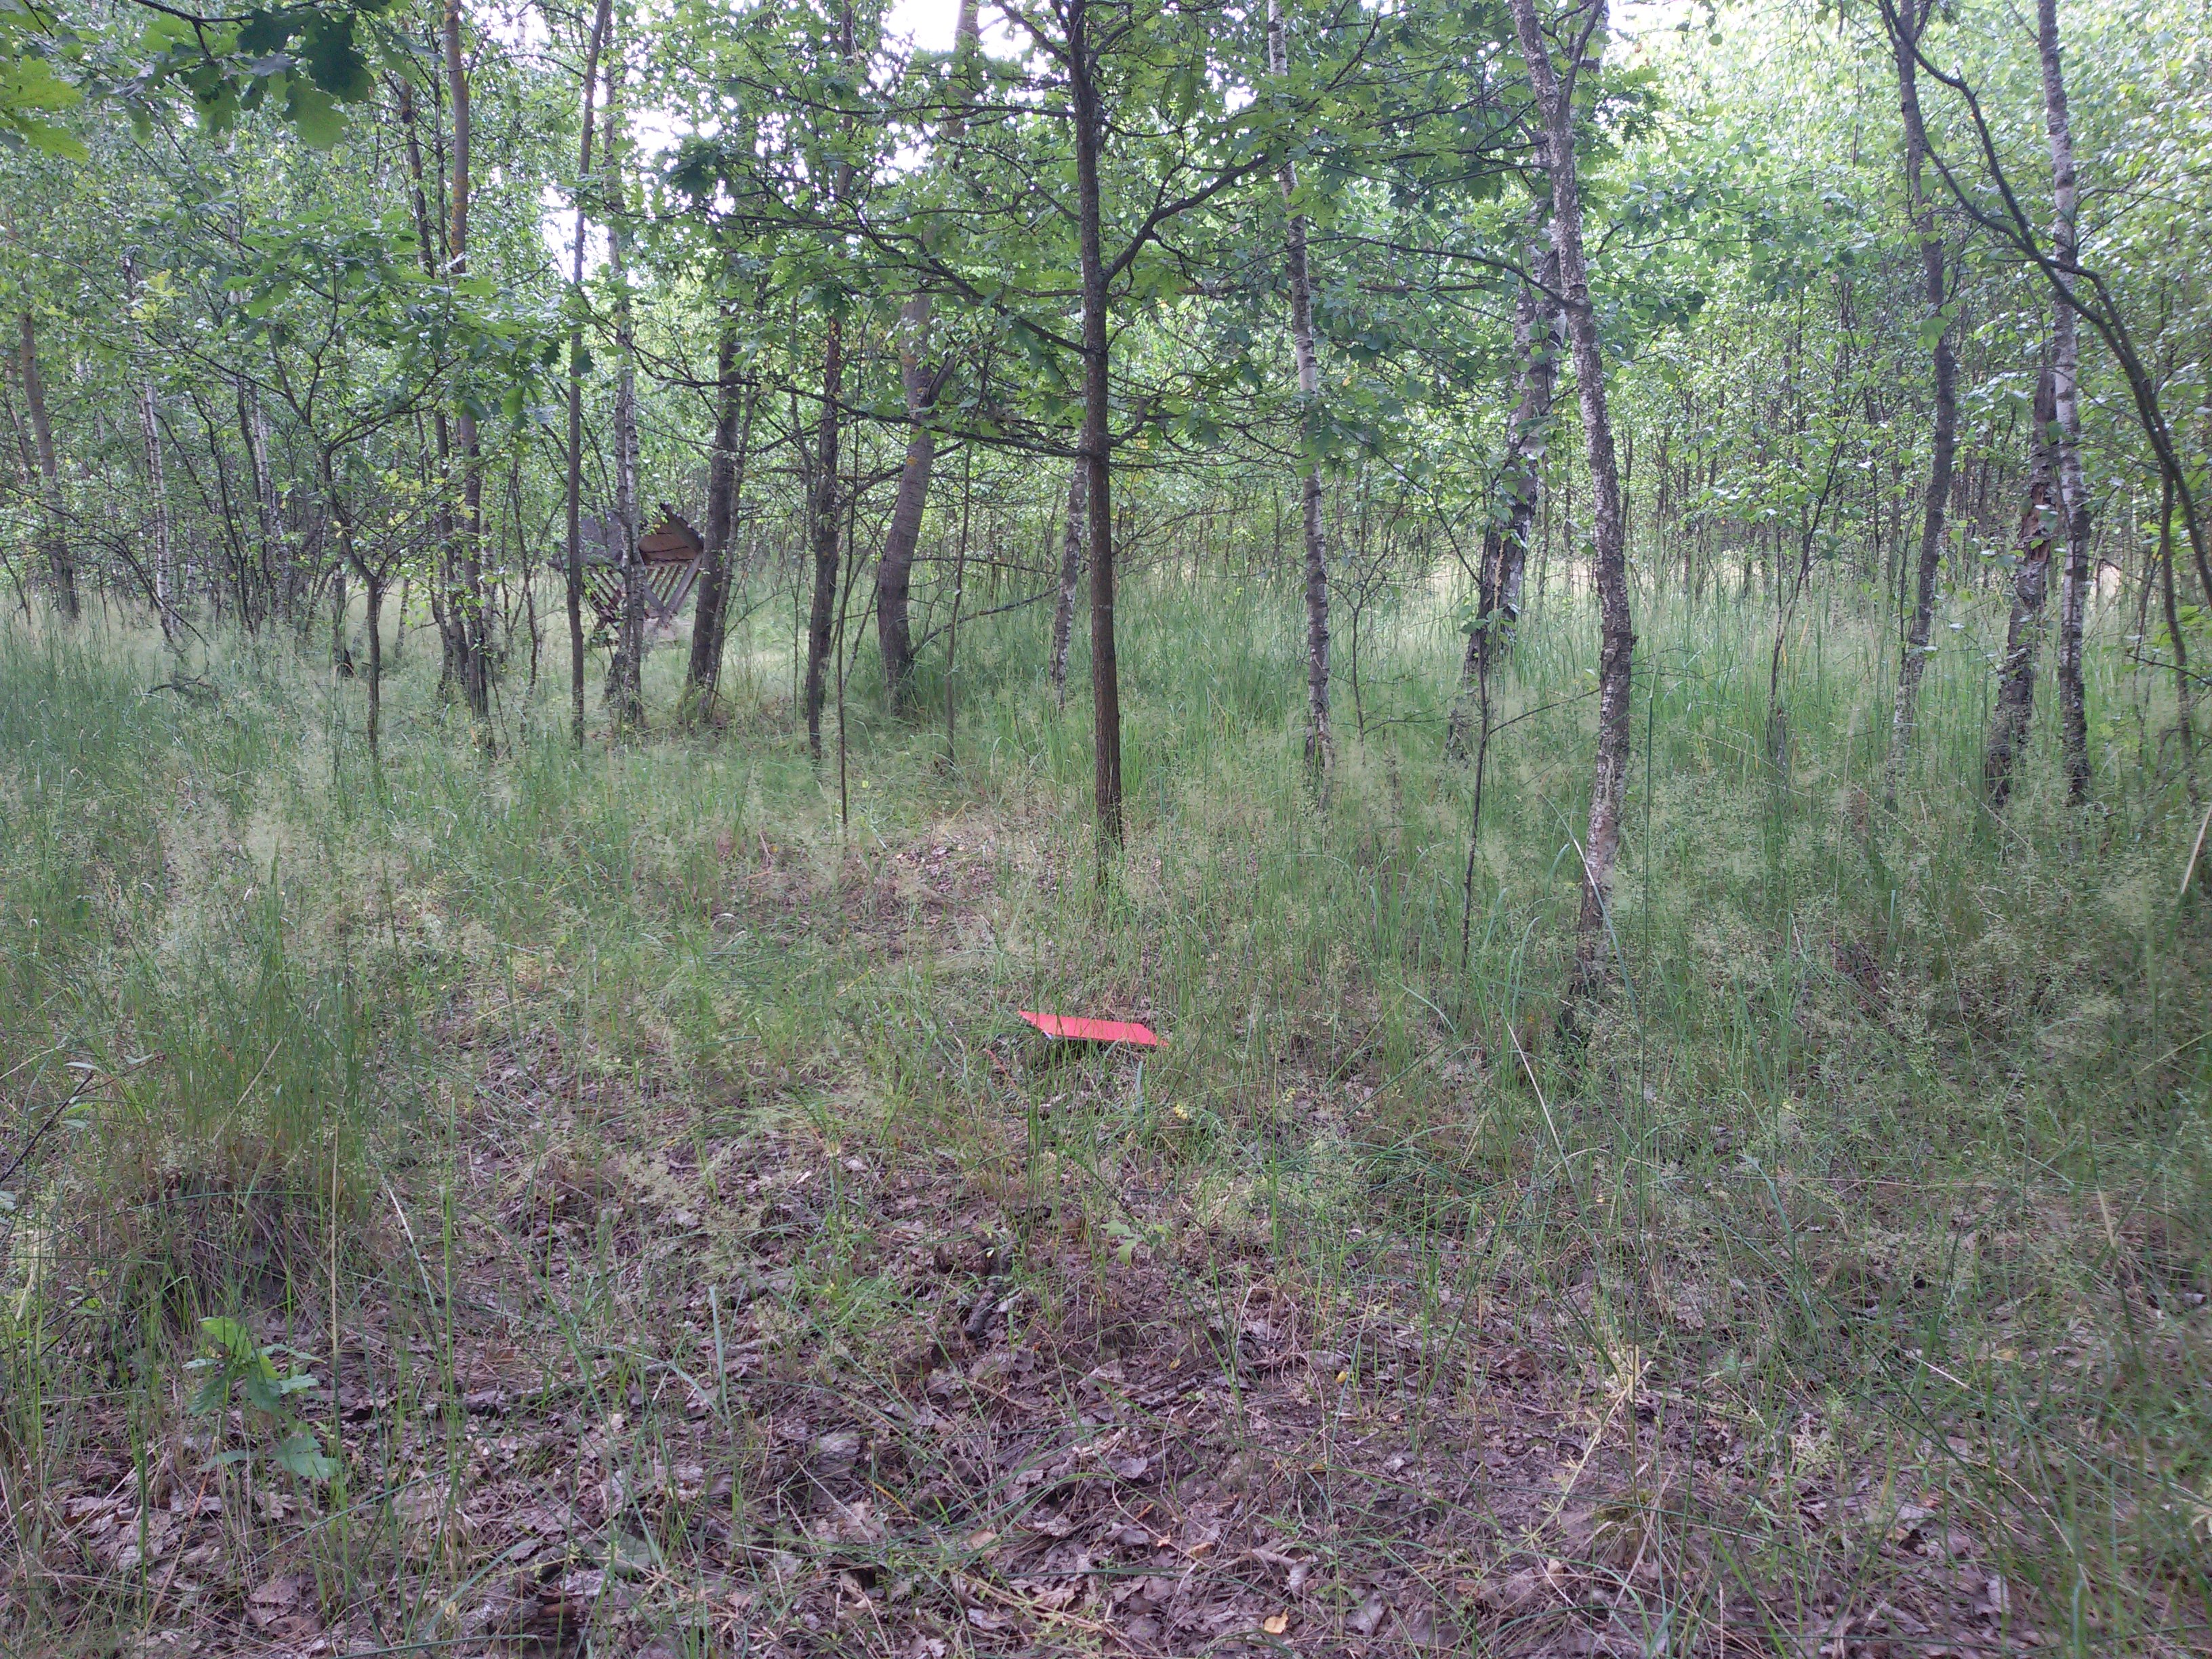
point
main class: Woodland
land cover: Broadleaved woodland
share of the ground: > 75 %
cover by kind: broadleaved forest trees 90 %, herbaceous plants 10 %
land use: Forestry
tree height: > 5 m
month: June
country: PL
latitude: 51.7631
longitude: 23.0438
